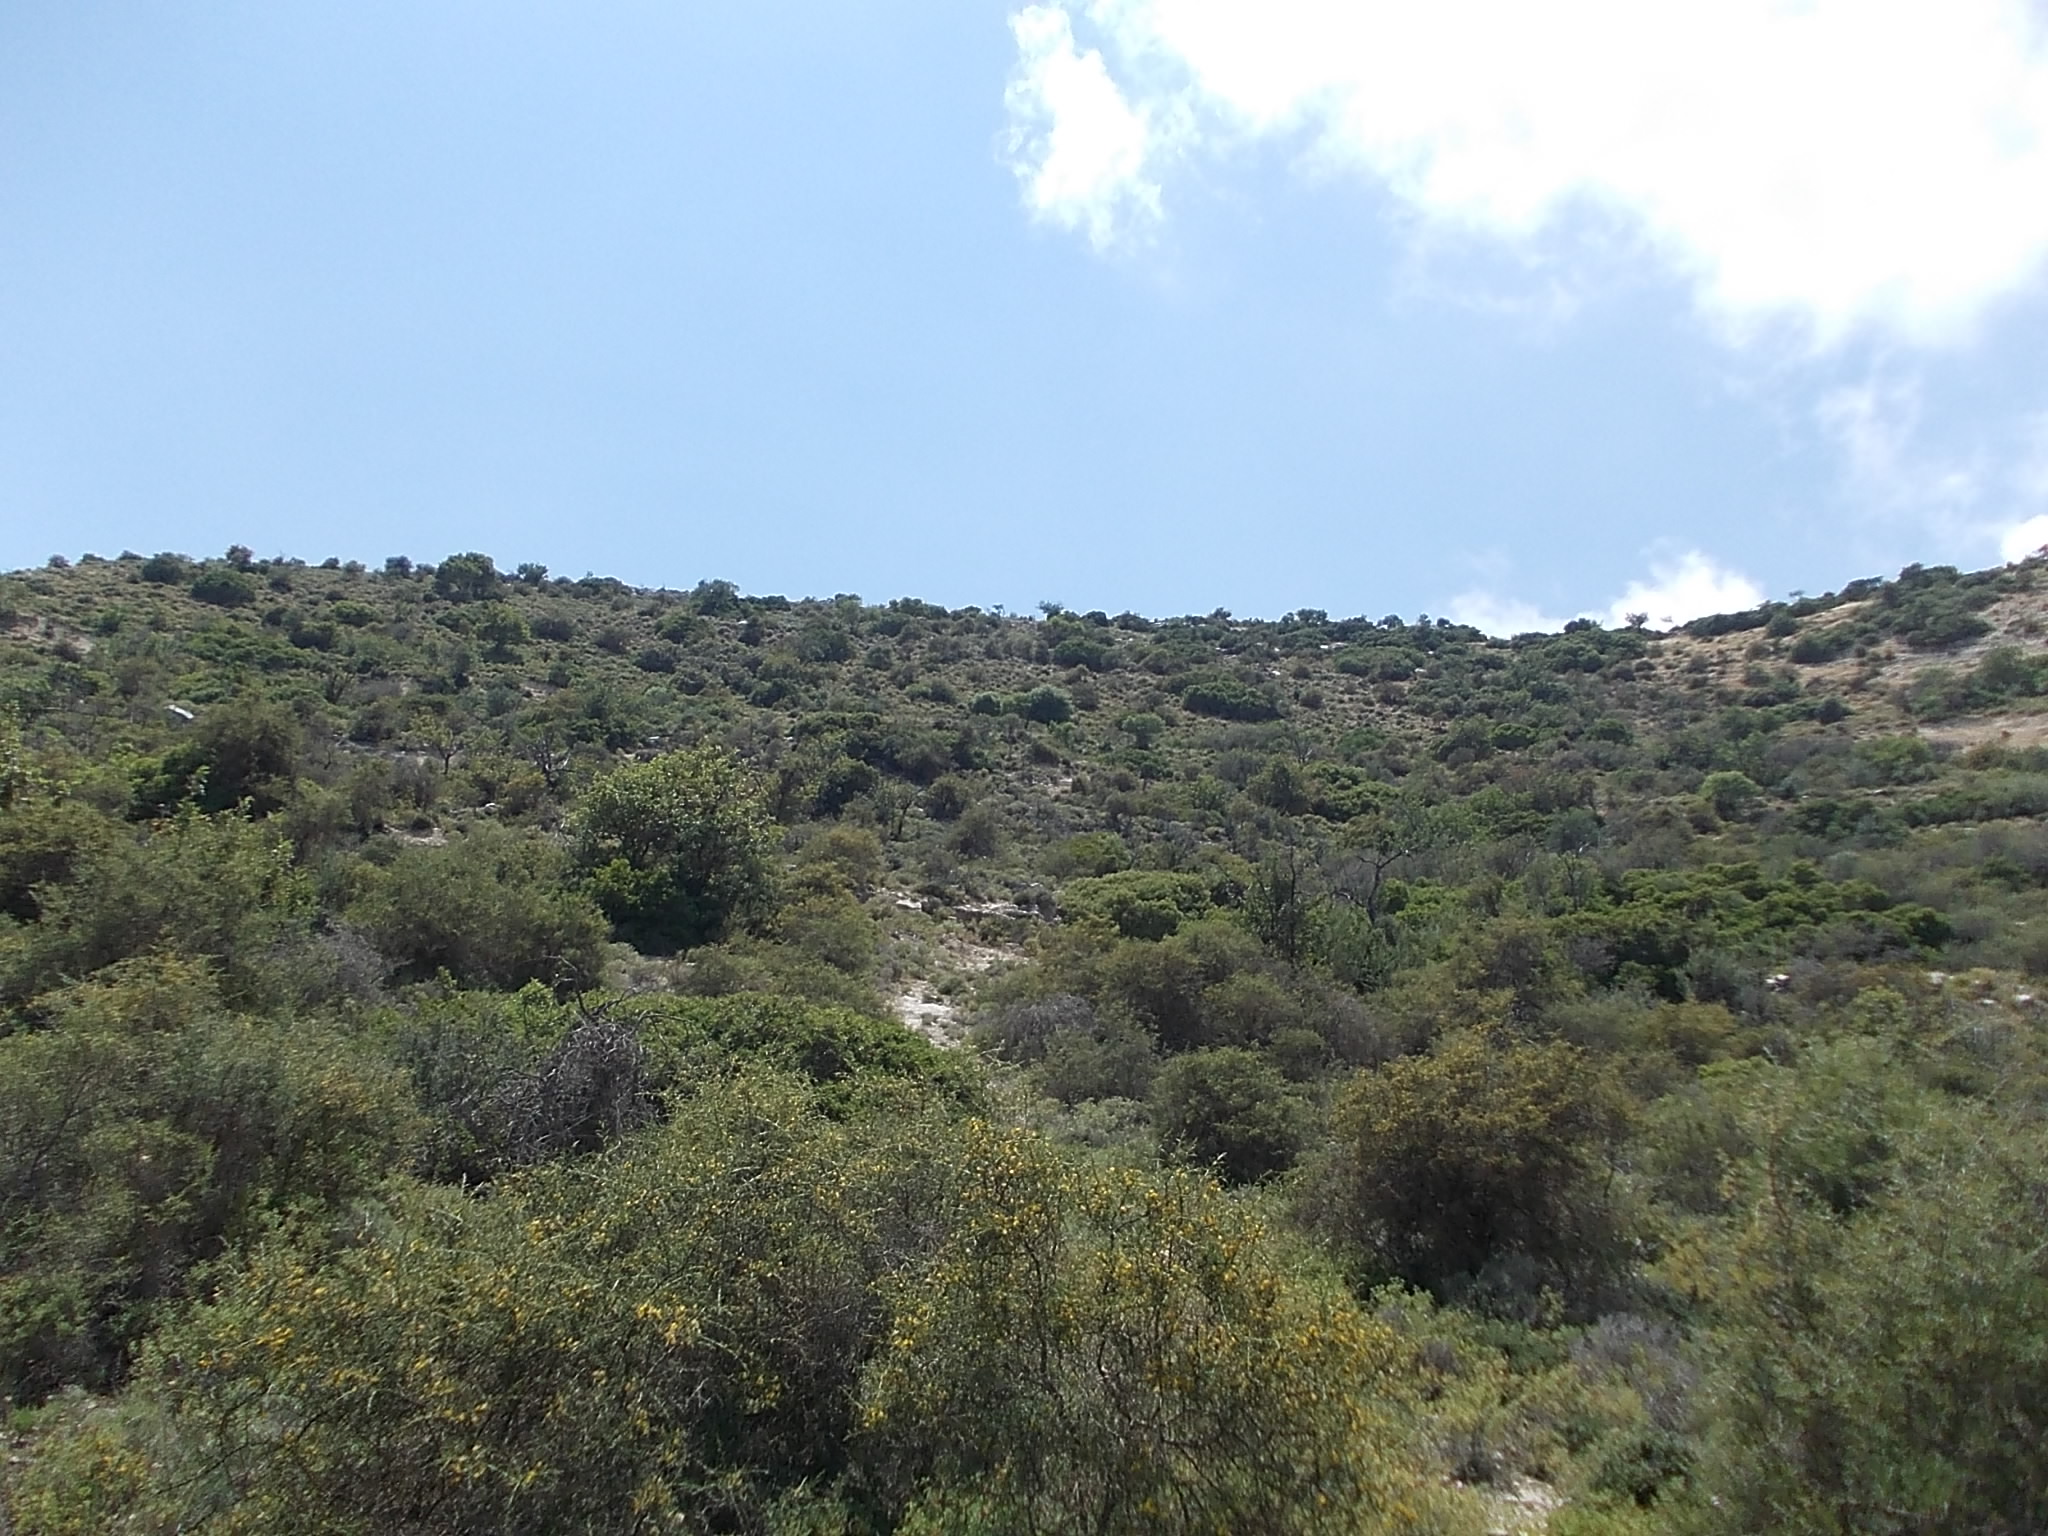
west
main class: Shrubland
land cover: Shrubland without tree cover
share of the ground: > 75 %
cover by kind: shrubs 85 %, unconsolidated bare surface 15 %
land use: Semi-natural and natural areas not in use
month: June
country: CY
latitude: 34.7197
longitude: 32.7022
